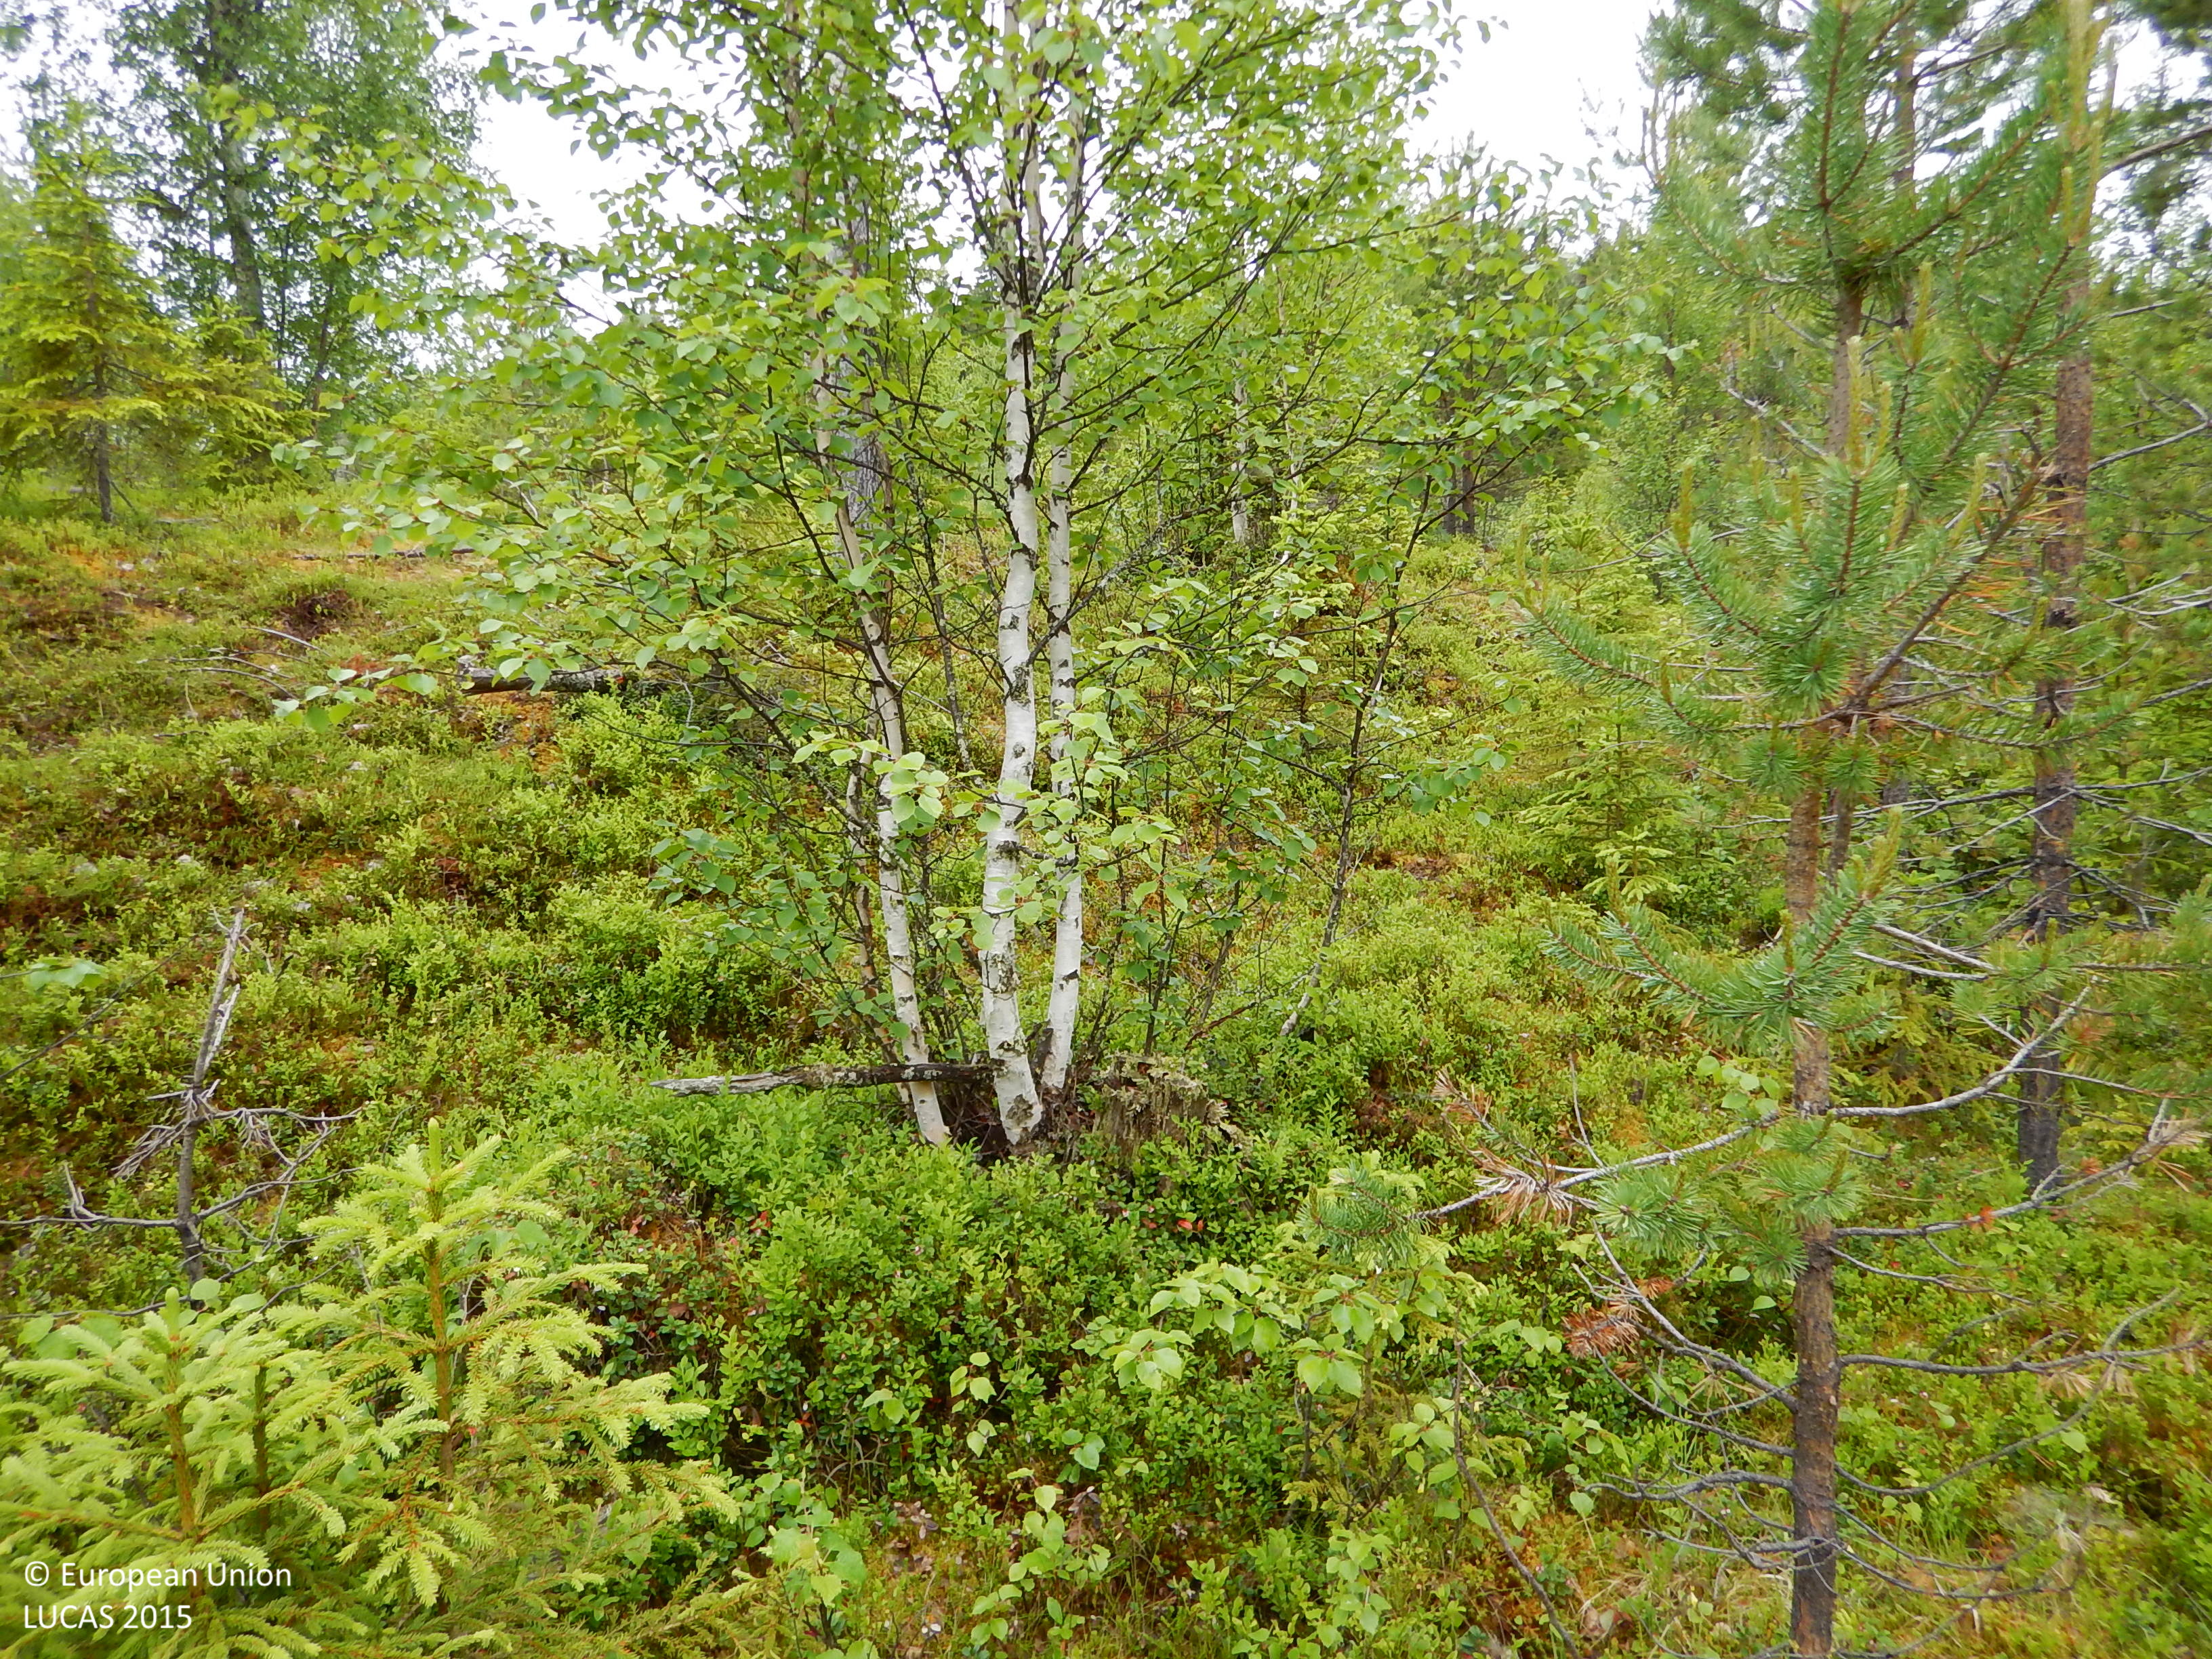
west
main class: Woodland
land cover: Pine dominated mixed woodland
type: boreal forest
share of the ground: 25 - 50 %
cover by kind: herbaceous plants 40 %, lichens and mosses 25 %, coniferous forest trees 20 %, broadleaved forest trees 10 %, shrubs 5 %
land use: Forestry
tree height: < 5 m
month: July
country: SE
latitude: 65.1626
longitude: 18.6471
